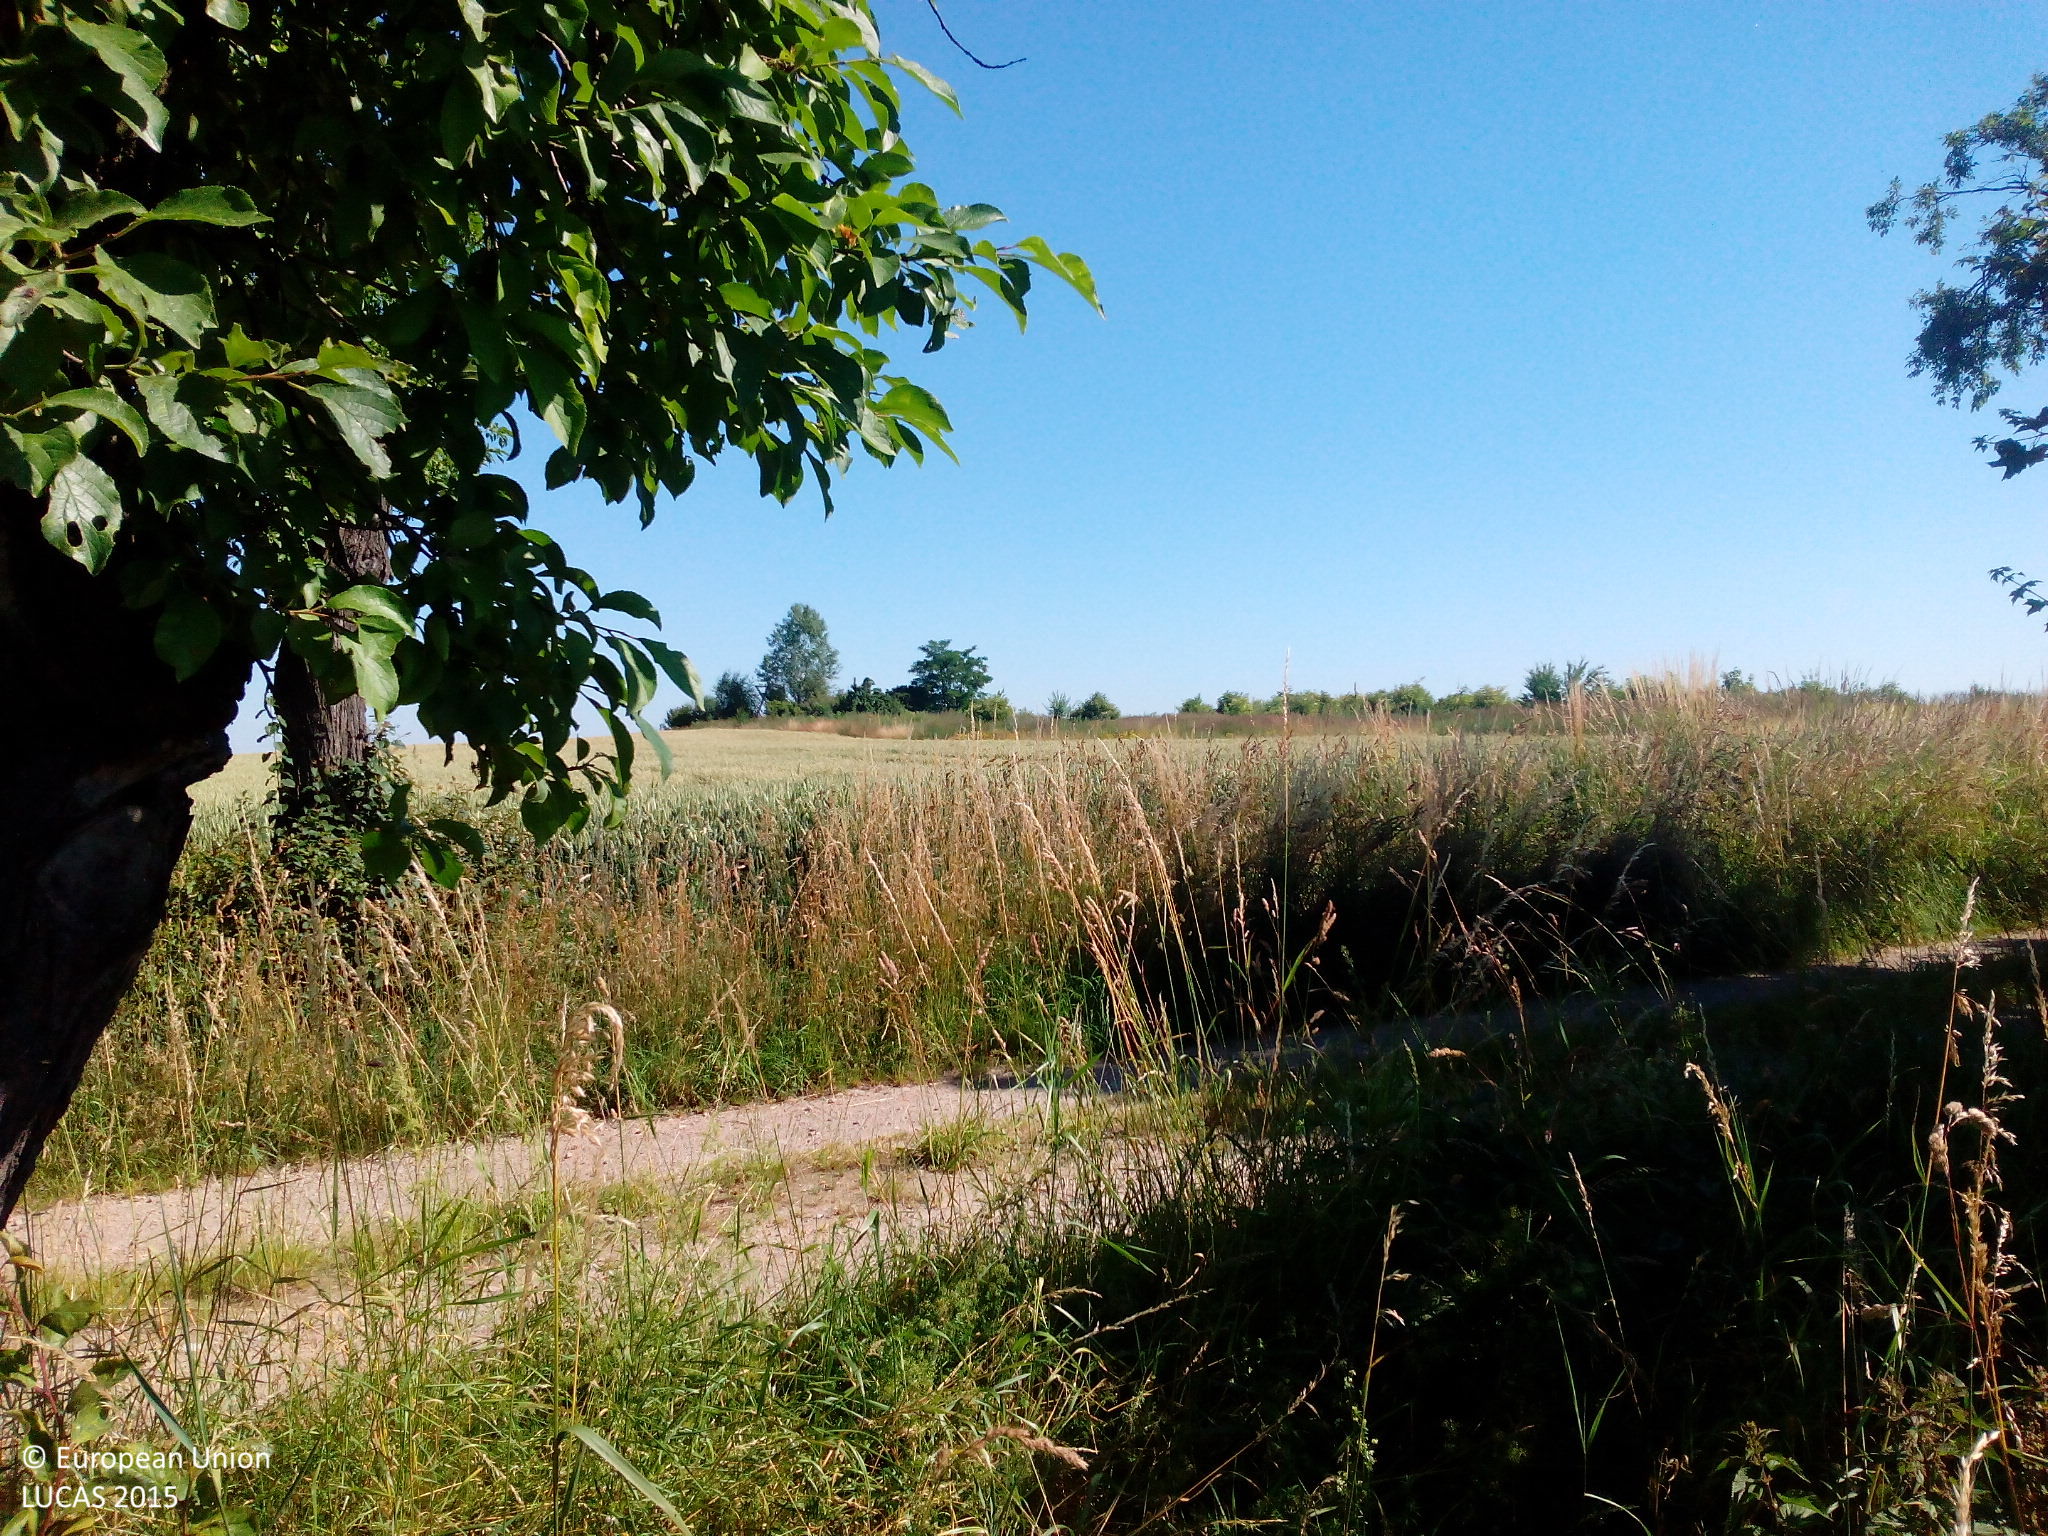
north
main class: Cropland
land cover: Rape and turnip rape
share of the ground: > 75 %
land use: Agriculture (excluding fallow land and kitchen gardens)
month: July
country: DE
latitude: 51.3293
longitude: 13.1144
